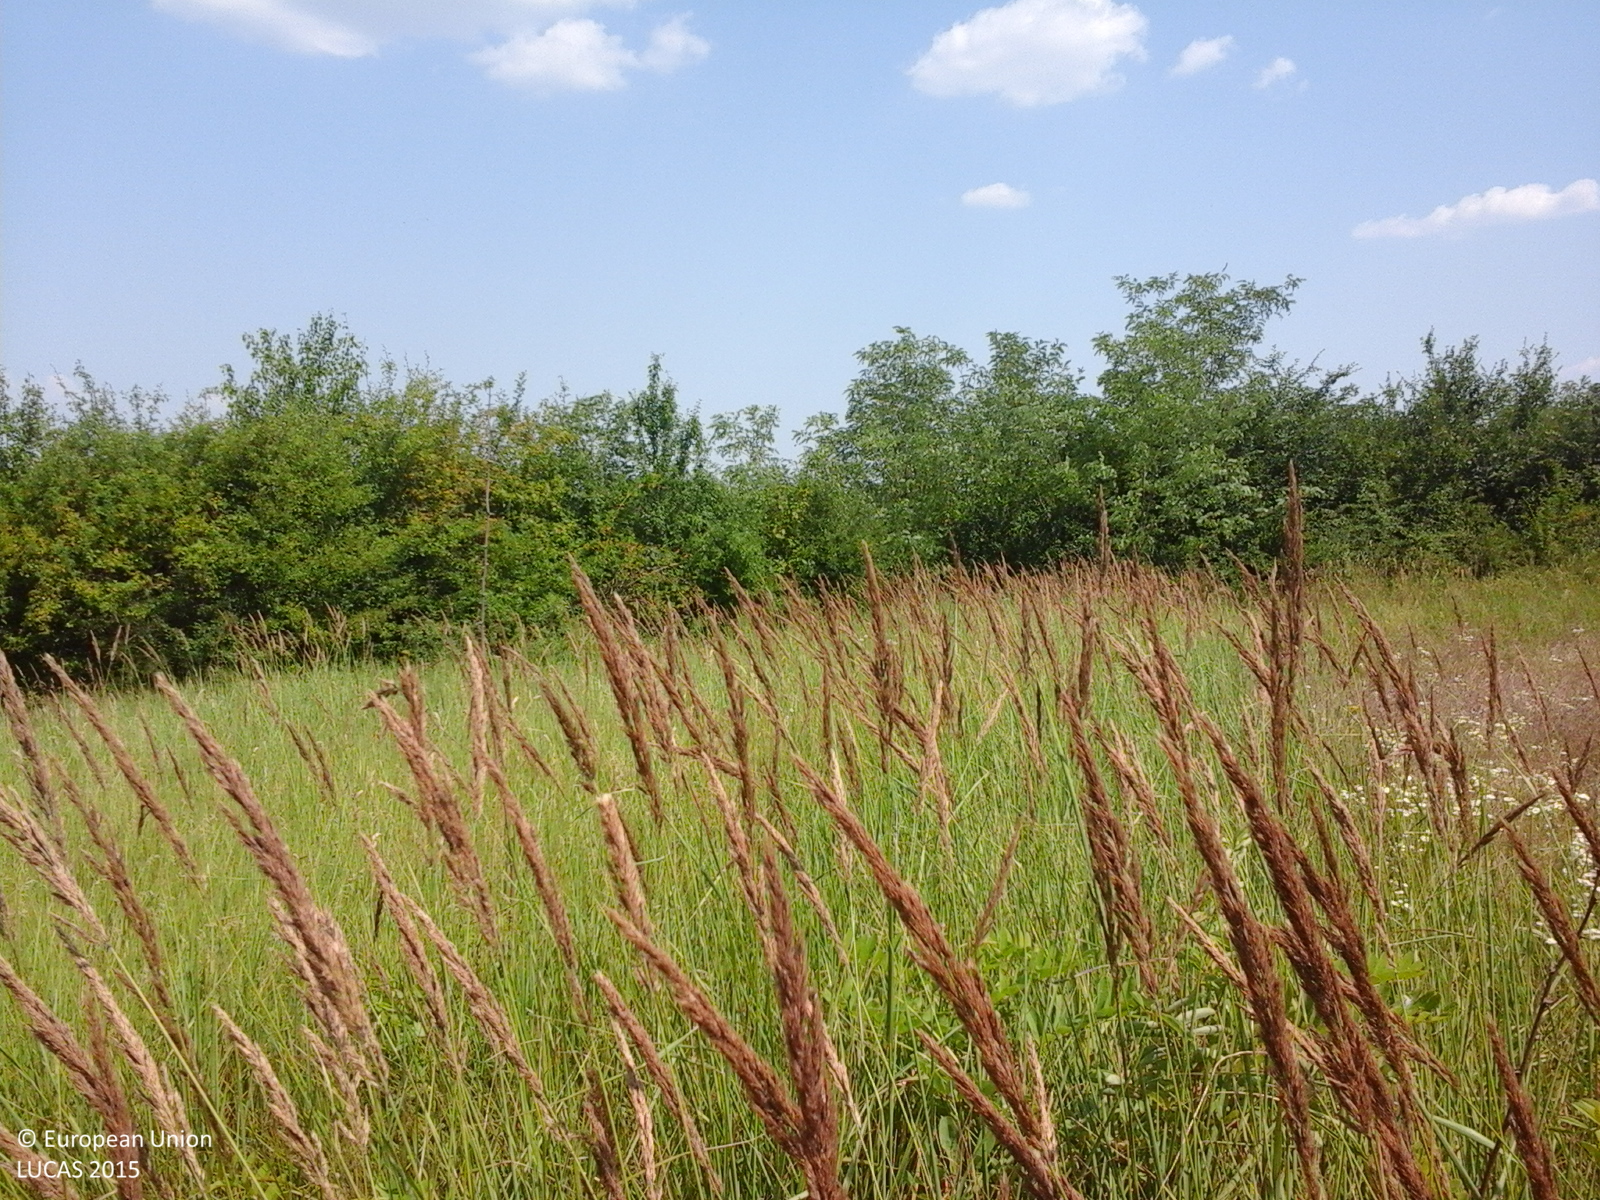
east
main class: Grassland
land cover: Spontaneously vegetated surfaces
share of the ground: > 75 %
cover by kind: herbaceous plants 100 %
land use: Fallow land
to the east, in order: Spontaneously vegetated surfaces; Broadleaved woodland; Ditches and canals; Broadleaved woodland
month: July
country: RO
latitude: 44.7375
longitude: 24.6106
